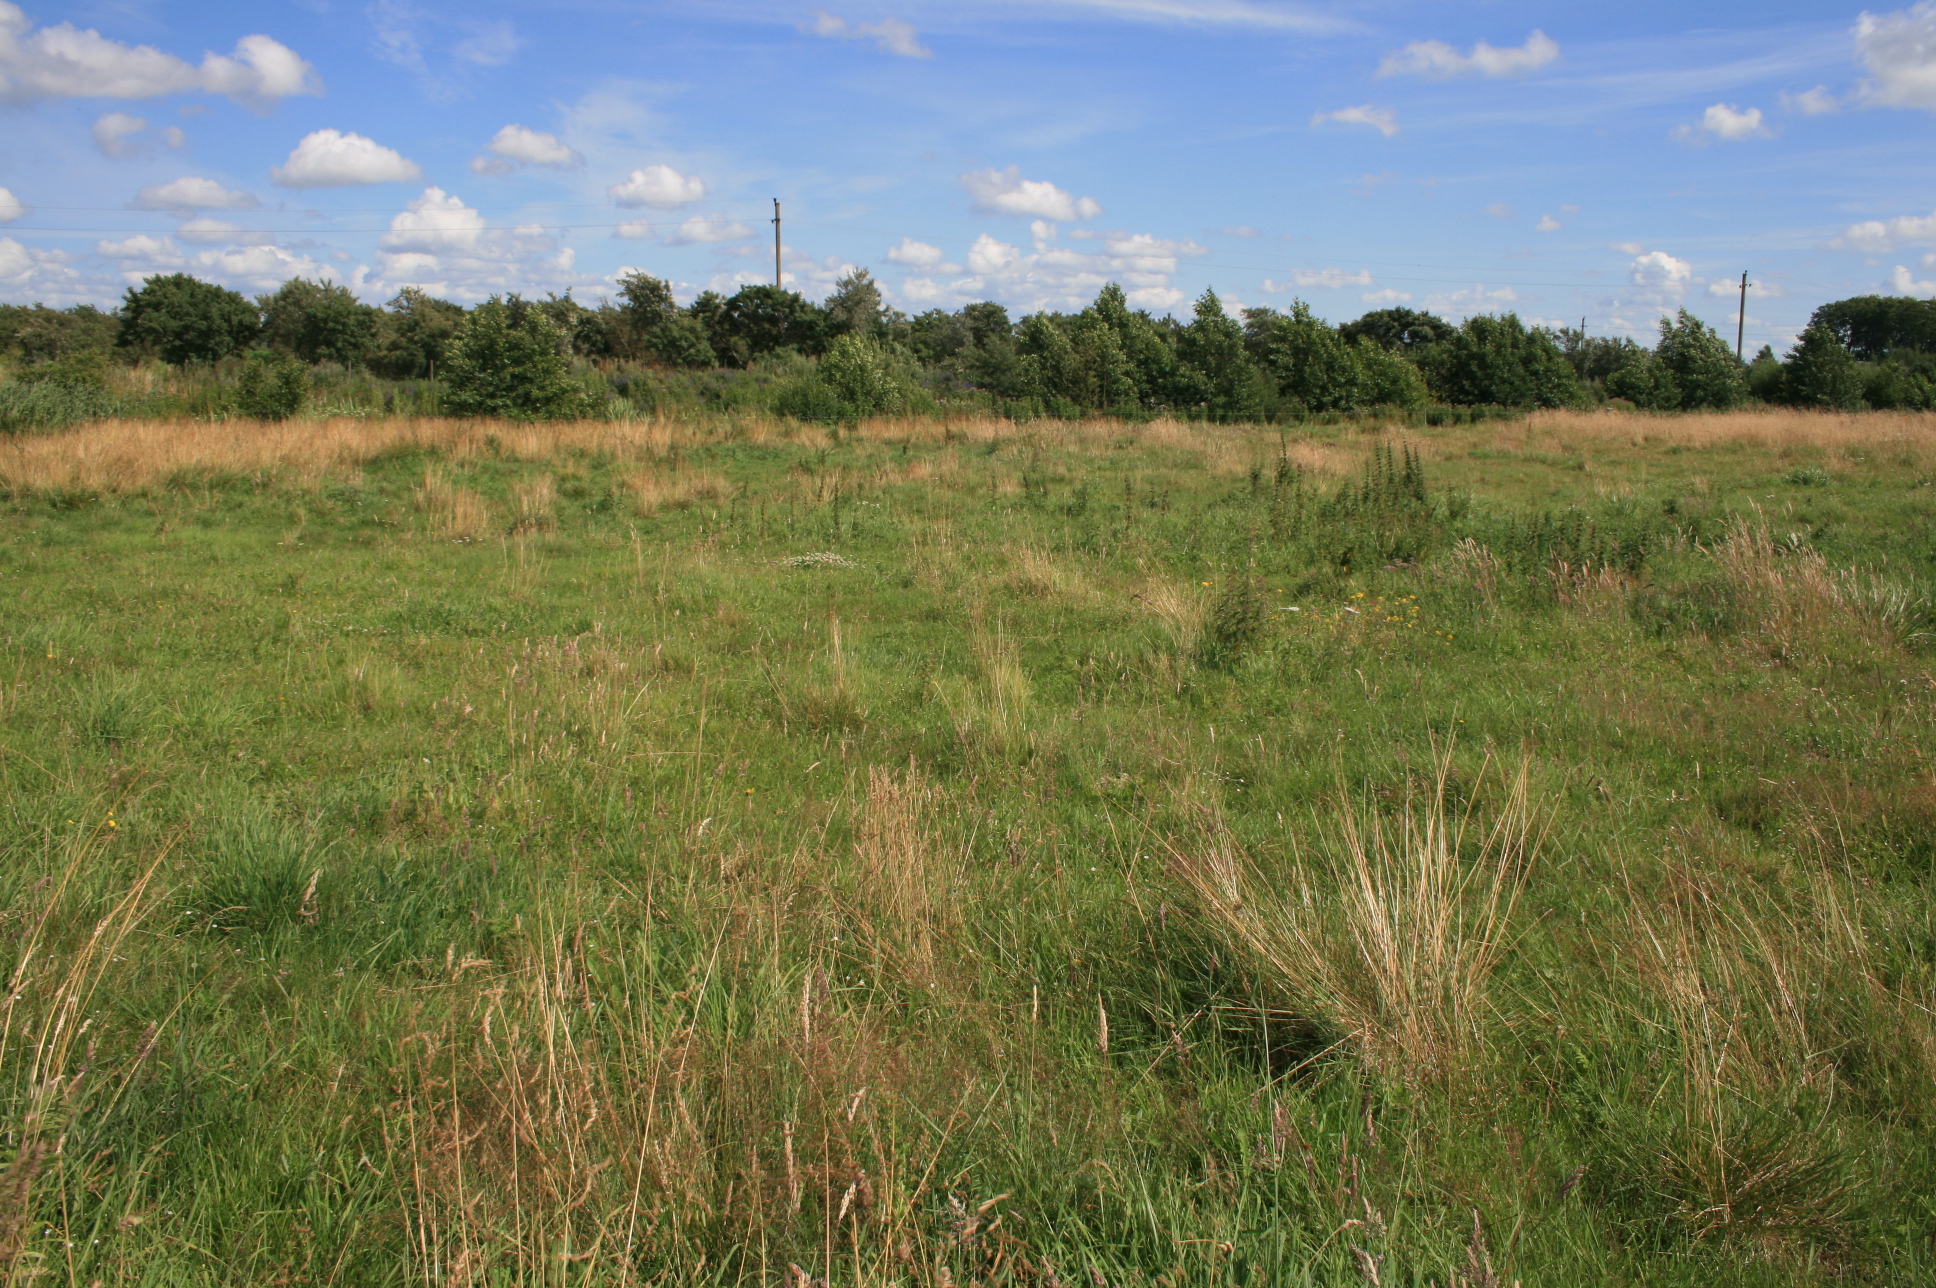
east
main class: Grassland
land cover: Grassland without tree/shrub cover
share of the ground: > 75 %
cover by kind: herbaceous plants 100 %
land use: Agriculture (excluding fallow land and kitchen gardens)
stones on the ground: < 10 %
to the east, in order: Grassland without tree/shrub cover; Fences; Shruby margins; Abandoned hedges; Ditches and canals; Spontaneously vegetated surfaces; Paved roads, cycling and walking lanes; Grass margins; Other fruit trees and berries; Electric lines; Other fruit trees and berries
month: July
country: LT
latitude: 55.5433
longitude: 21.2790
